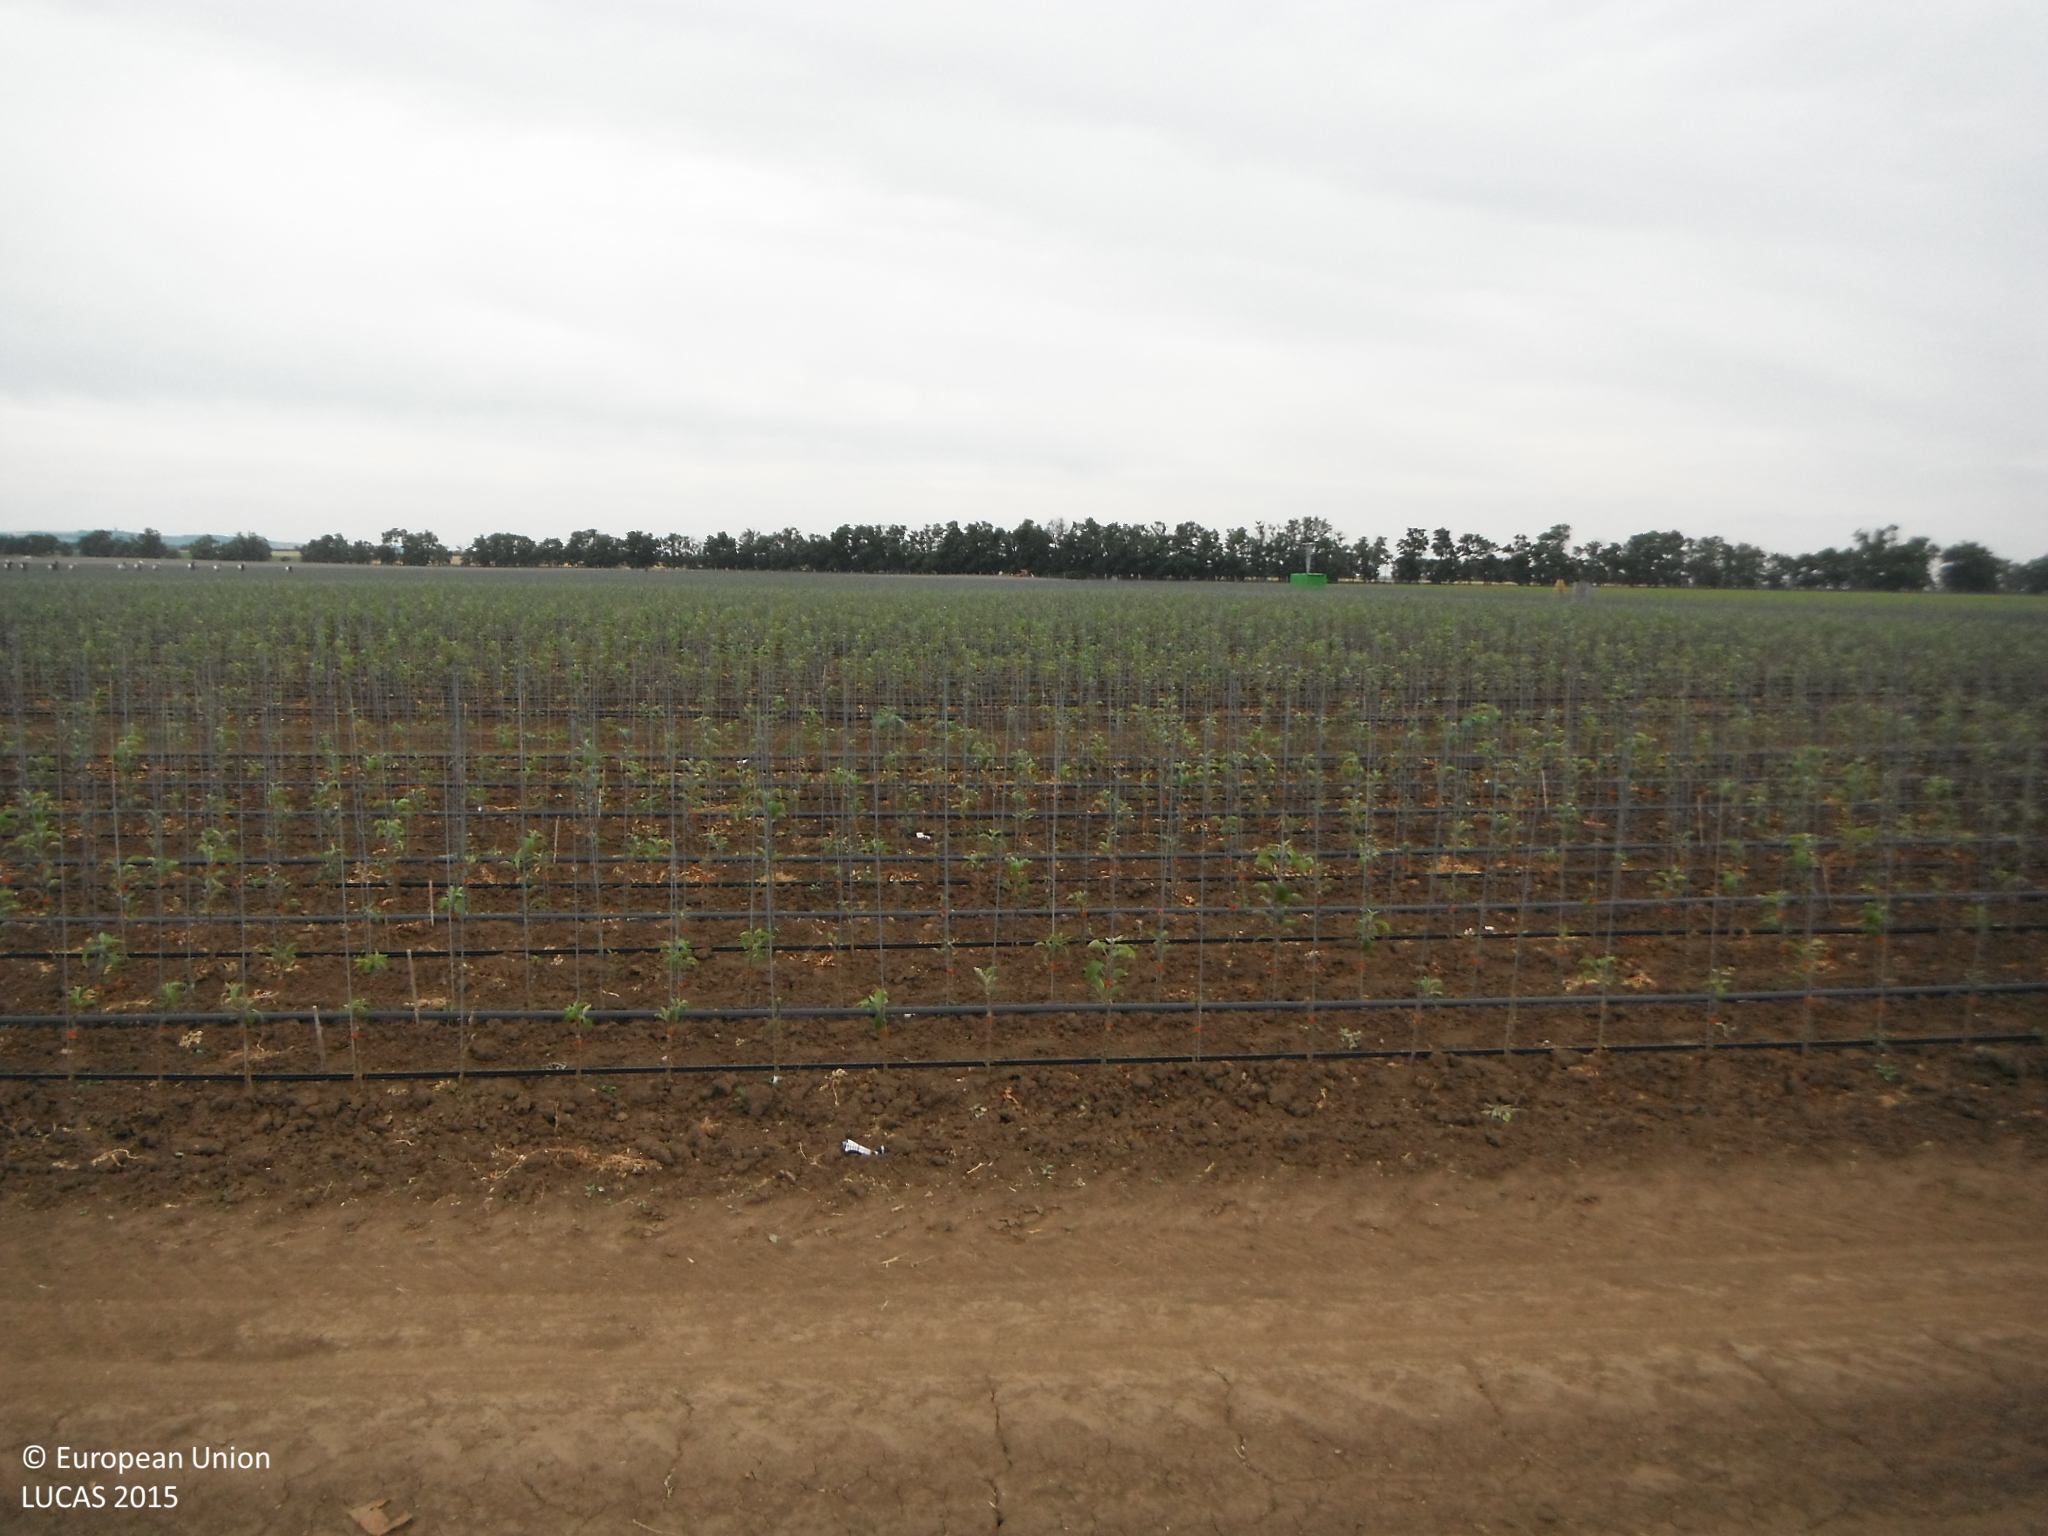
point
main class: Cropland
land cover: Apple fruit
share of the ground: 50 - 75 %
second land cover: Other bare soil
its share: > 75 %
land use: Agriculture (excluding fallow land and kitchen gardens)
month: June
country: SK
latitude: 48.4079
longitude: 17.6711
